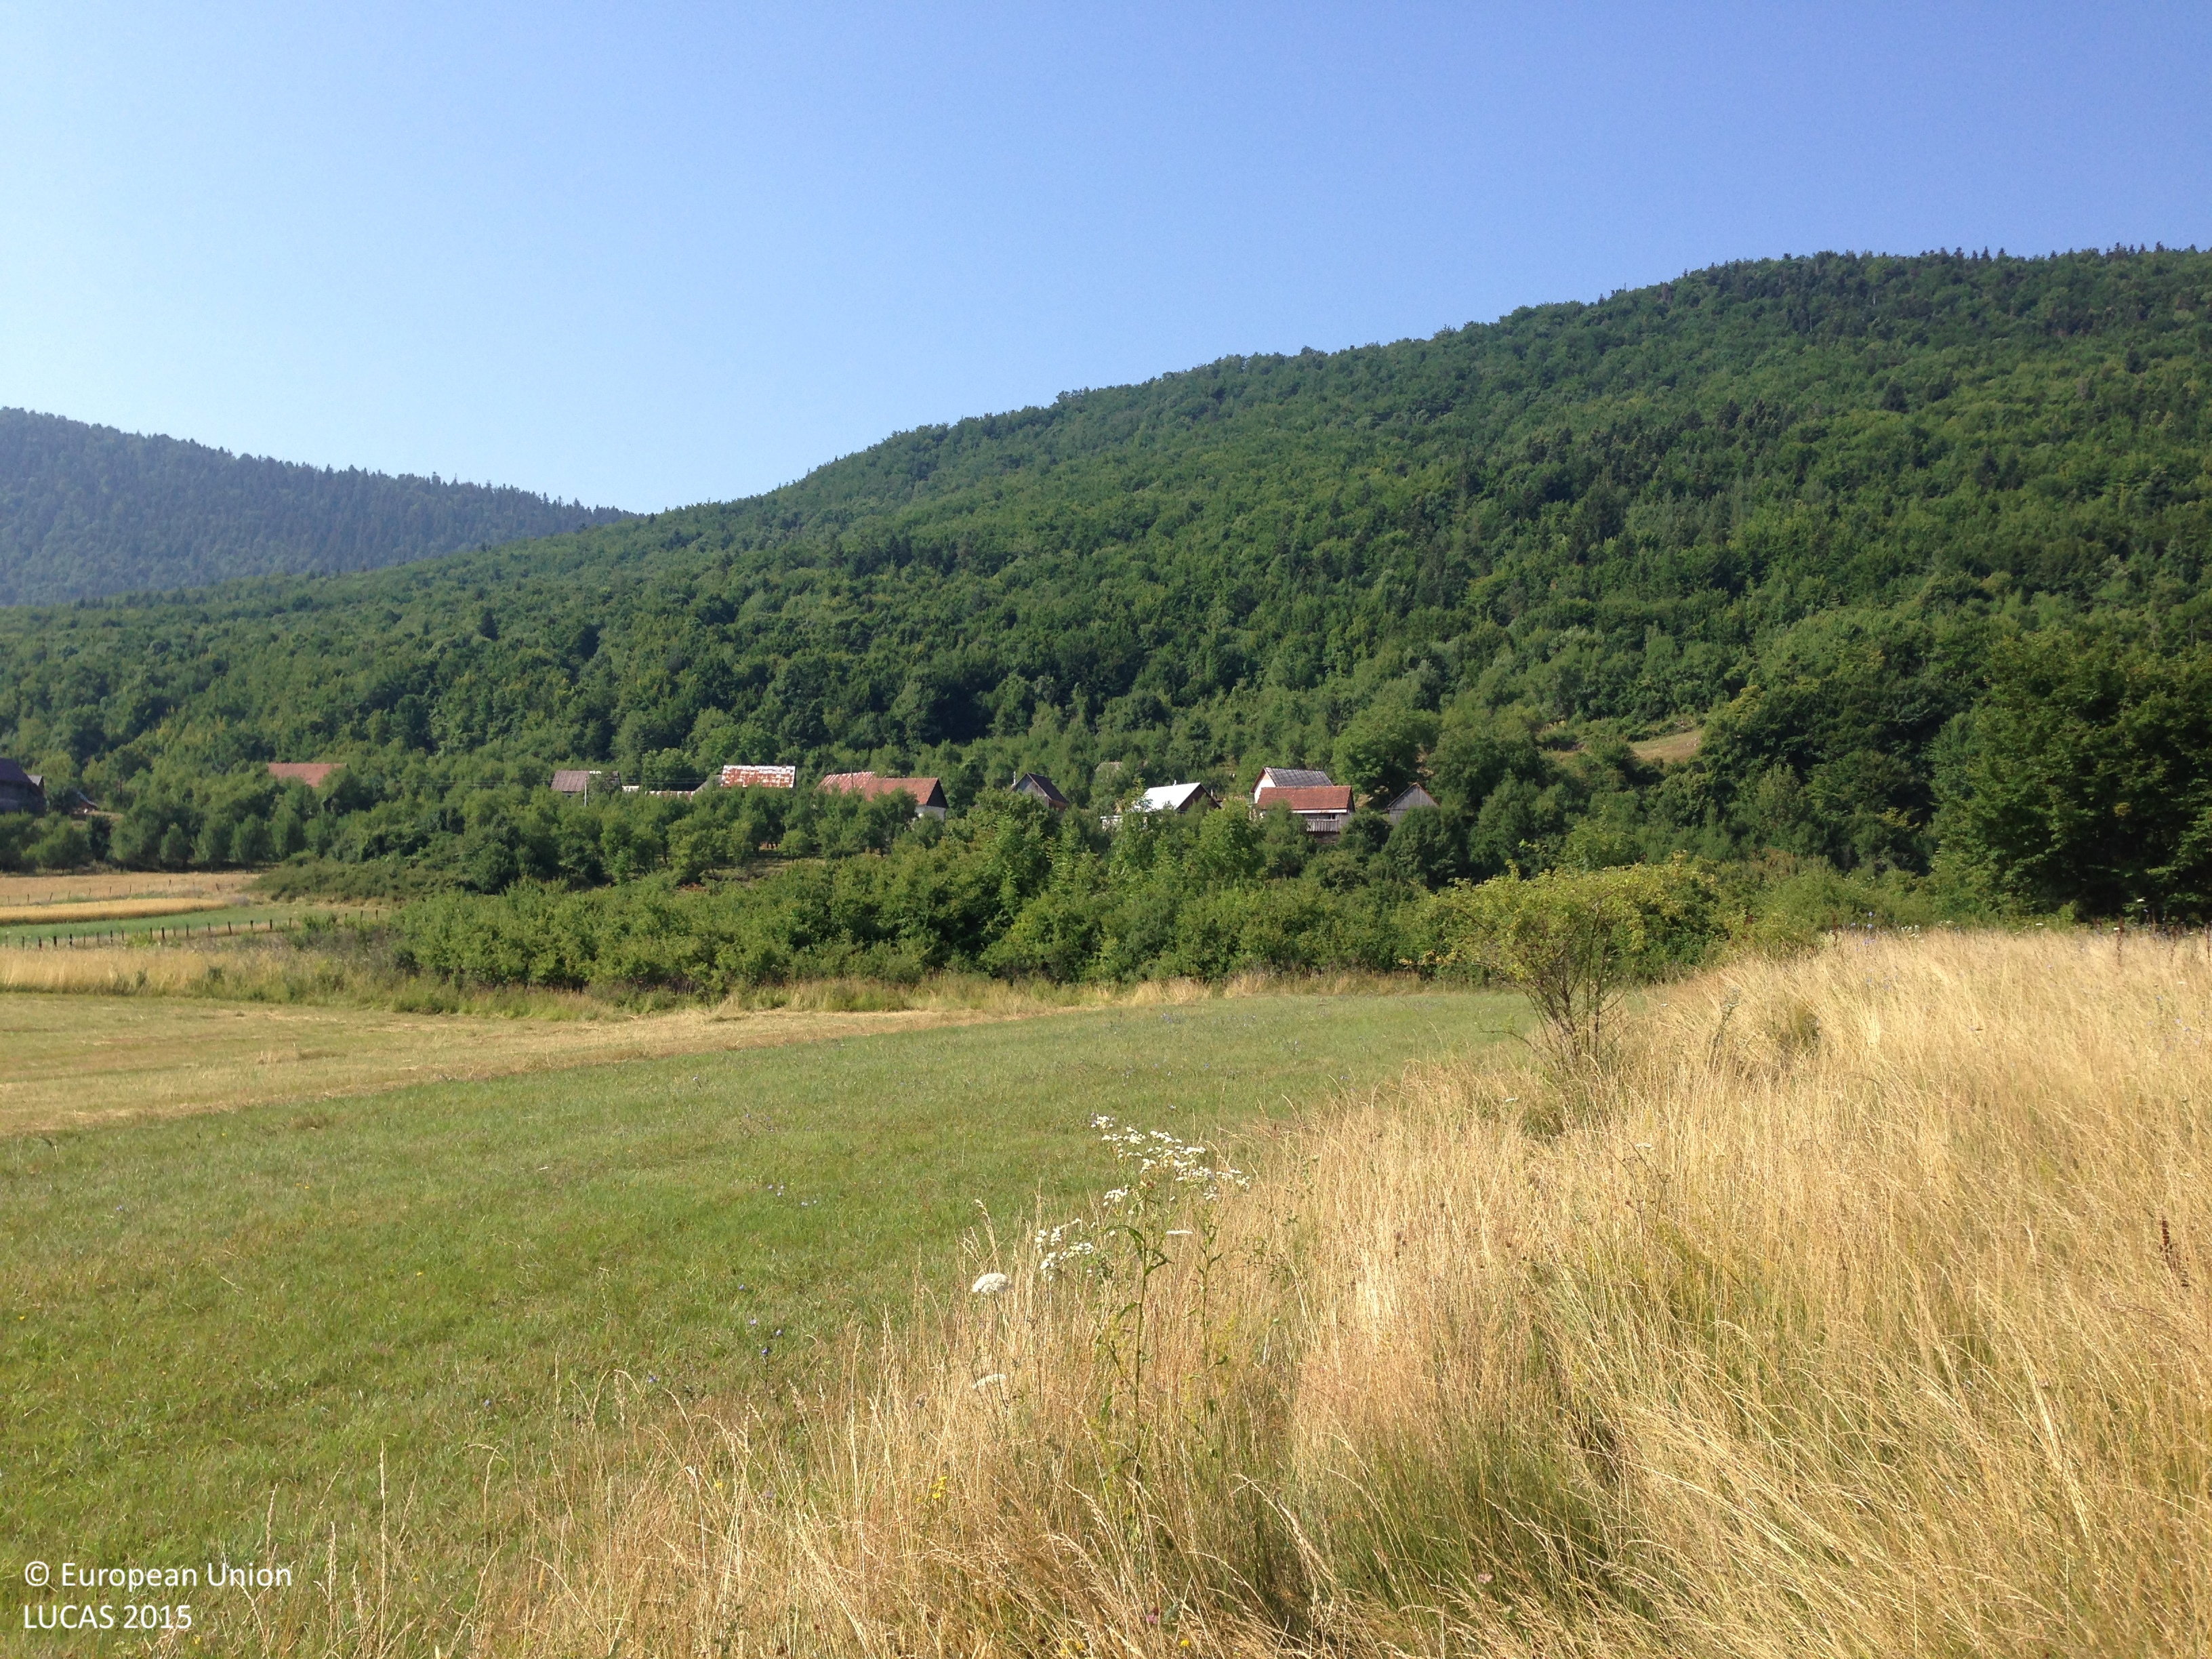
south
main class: Grassland
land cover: Grassland without tree/shrub cover
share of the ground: > 75 %
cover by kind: herbaceous plants 95 %, shrubs 5 %
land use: Agriculture (excluding fallow land and kitchen gardens)
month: July
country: HR
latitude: 44.7629
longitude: 15.1864
